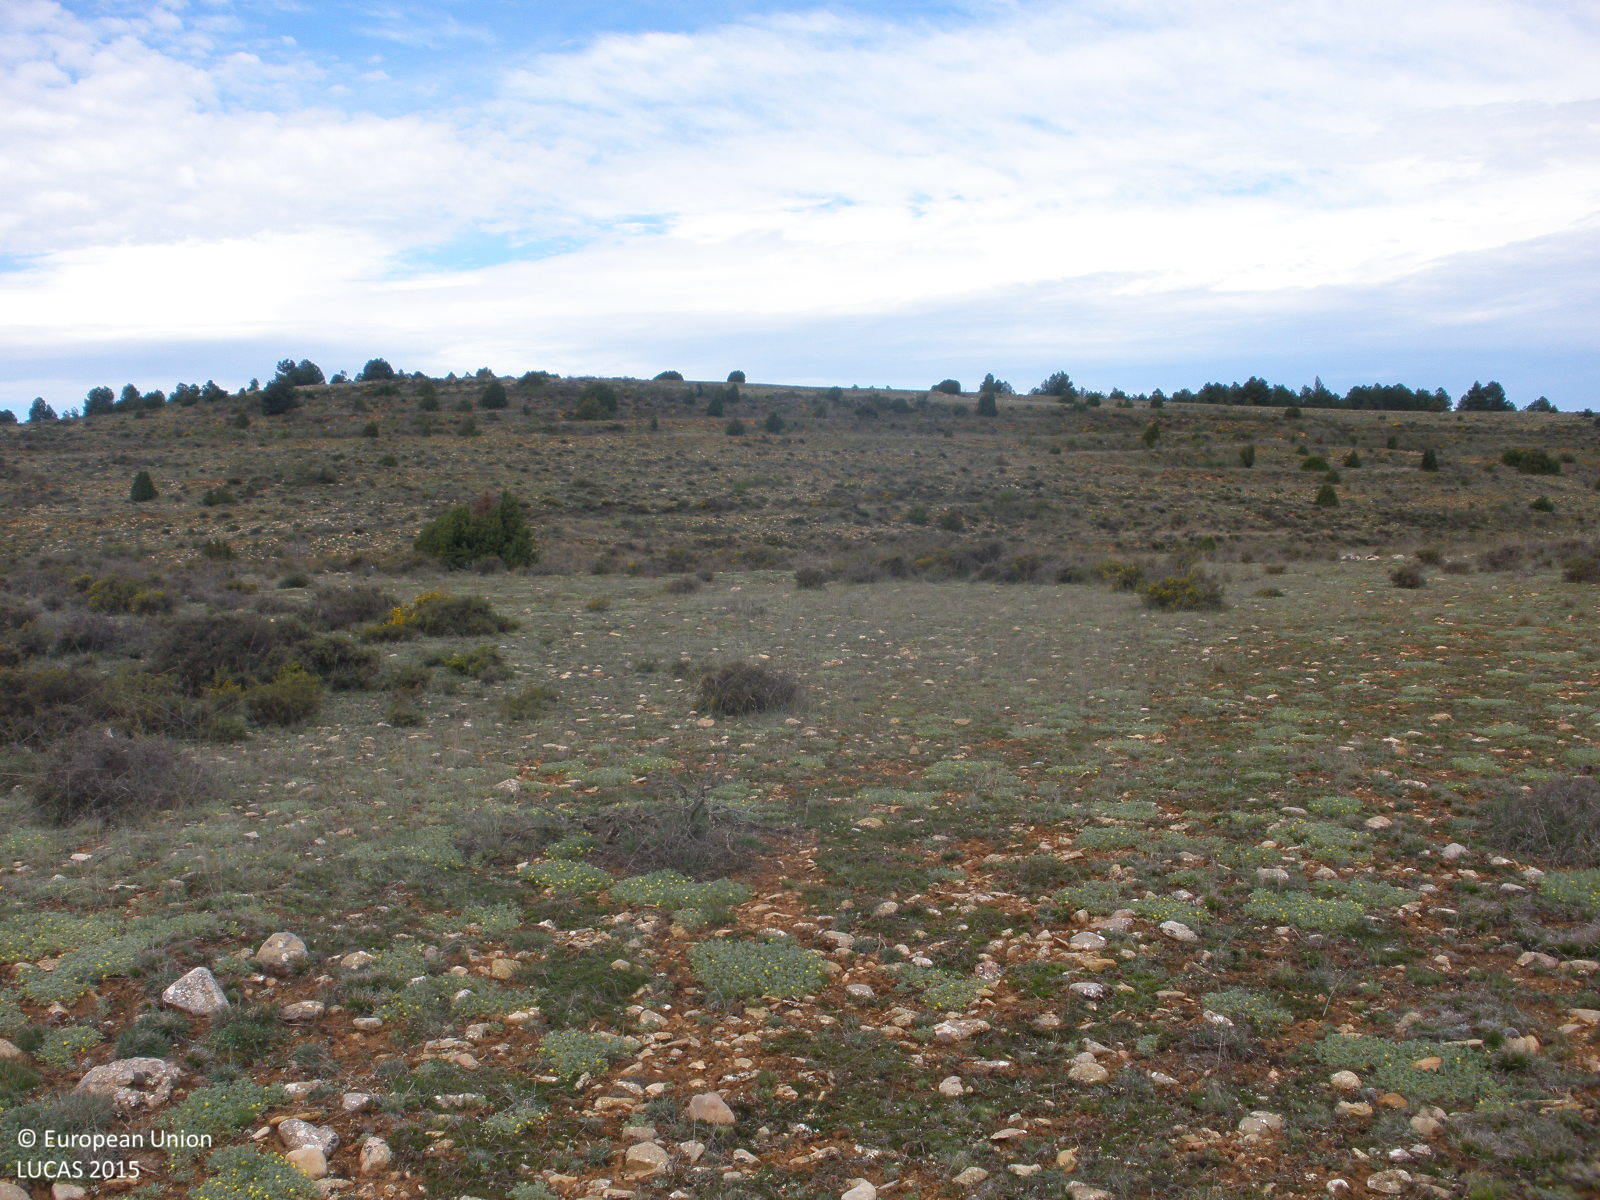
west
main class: Shrubland
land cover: Shrubland without tree cover
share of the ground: 25 - 50 %
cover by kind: herbaceous plants 50 %, shrubs 40 %, consolidated bare surface 10 %
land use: Semi-natural and natural areas not in use
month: May
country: ES
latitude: 40.4766
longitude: -0.7555
